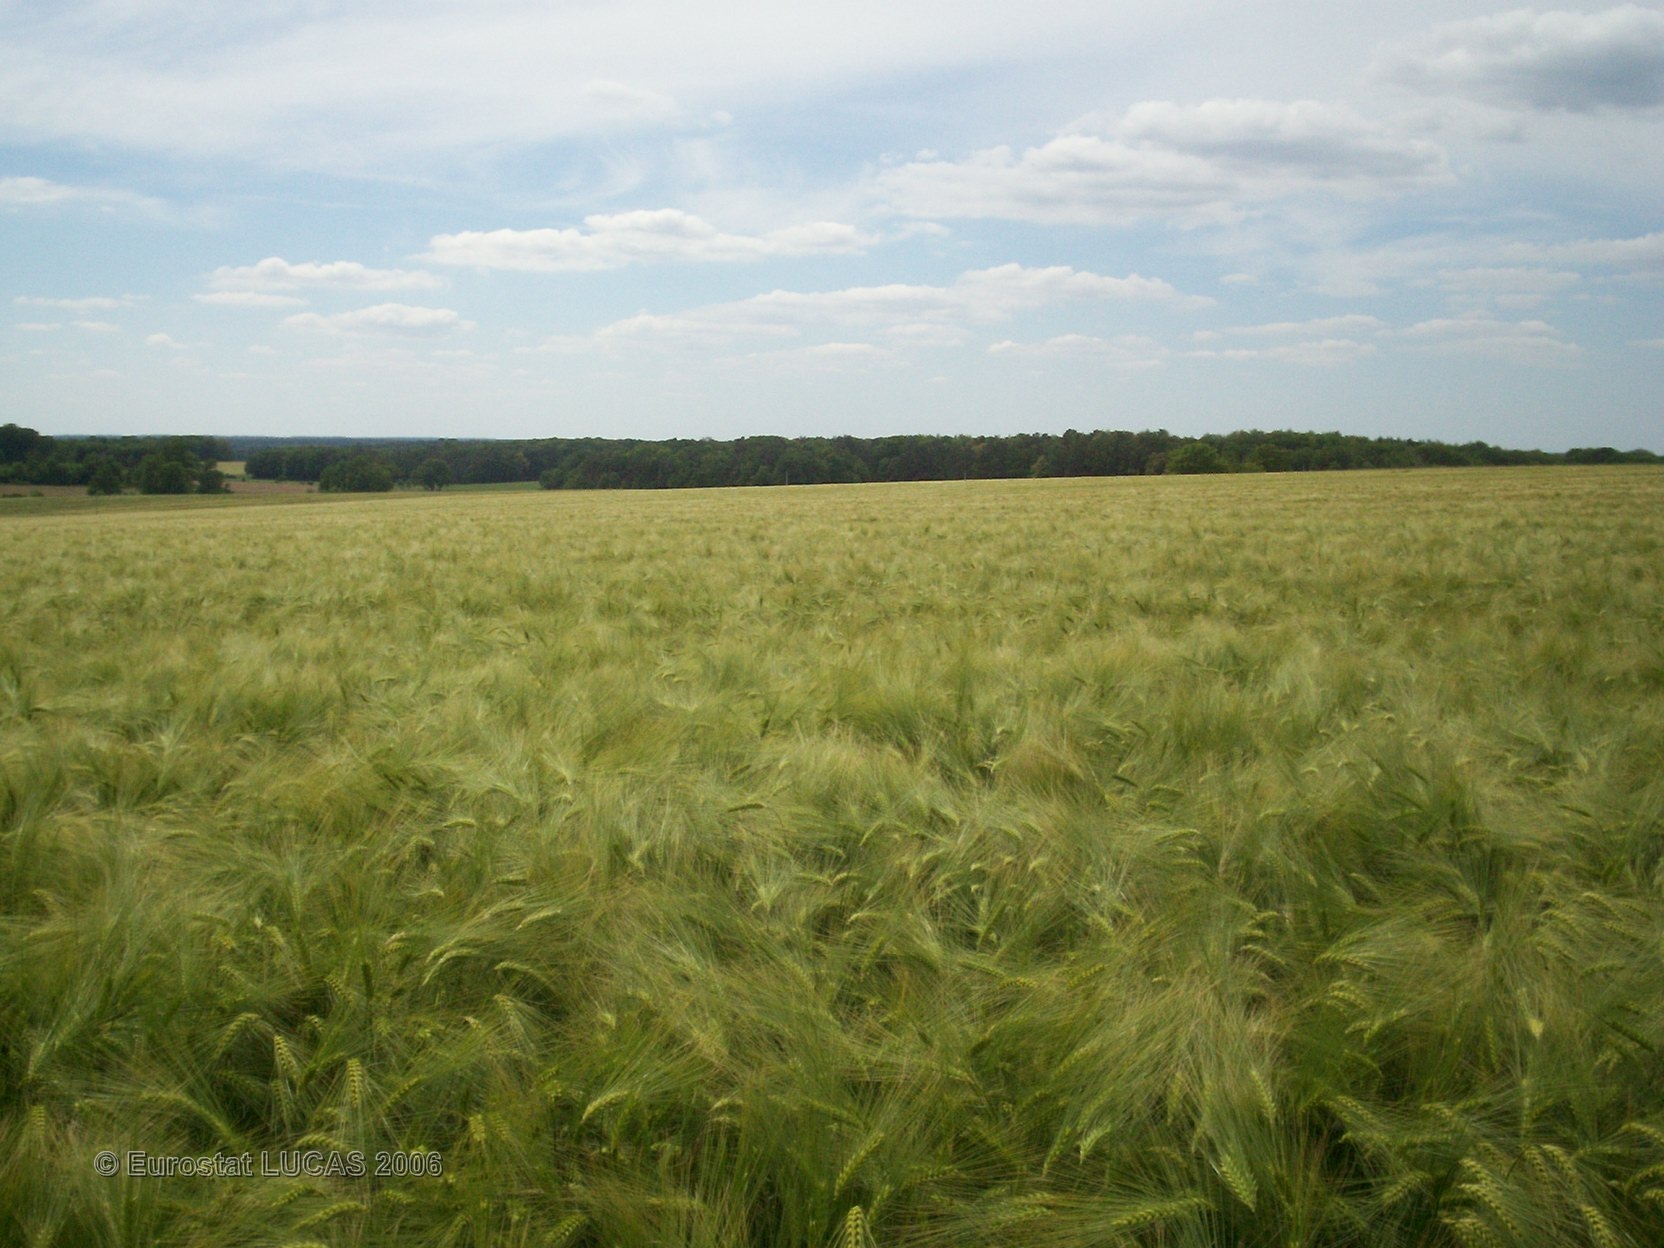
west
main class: Cropland
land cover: Barley
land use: Agriculture (excluding fallow land and kitchen gardens)
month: June
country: FR
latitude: 47.5205
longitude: 6.0039
